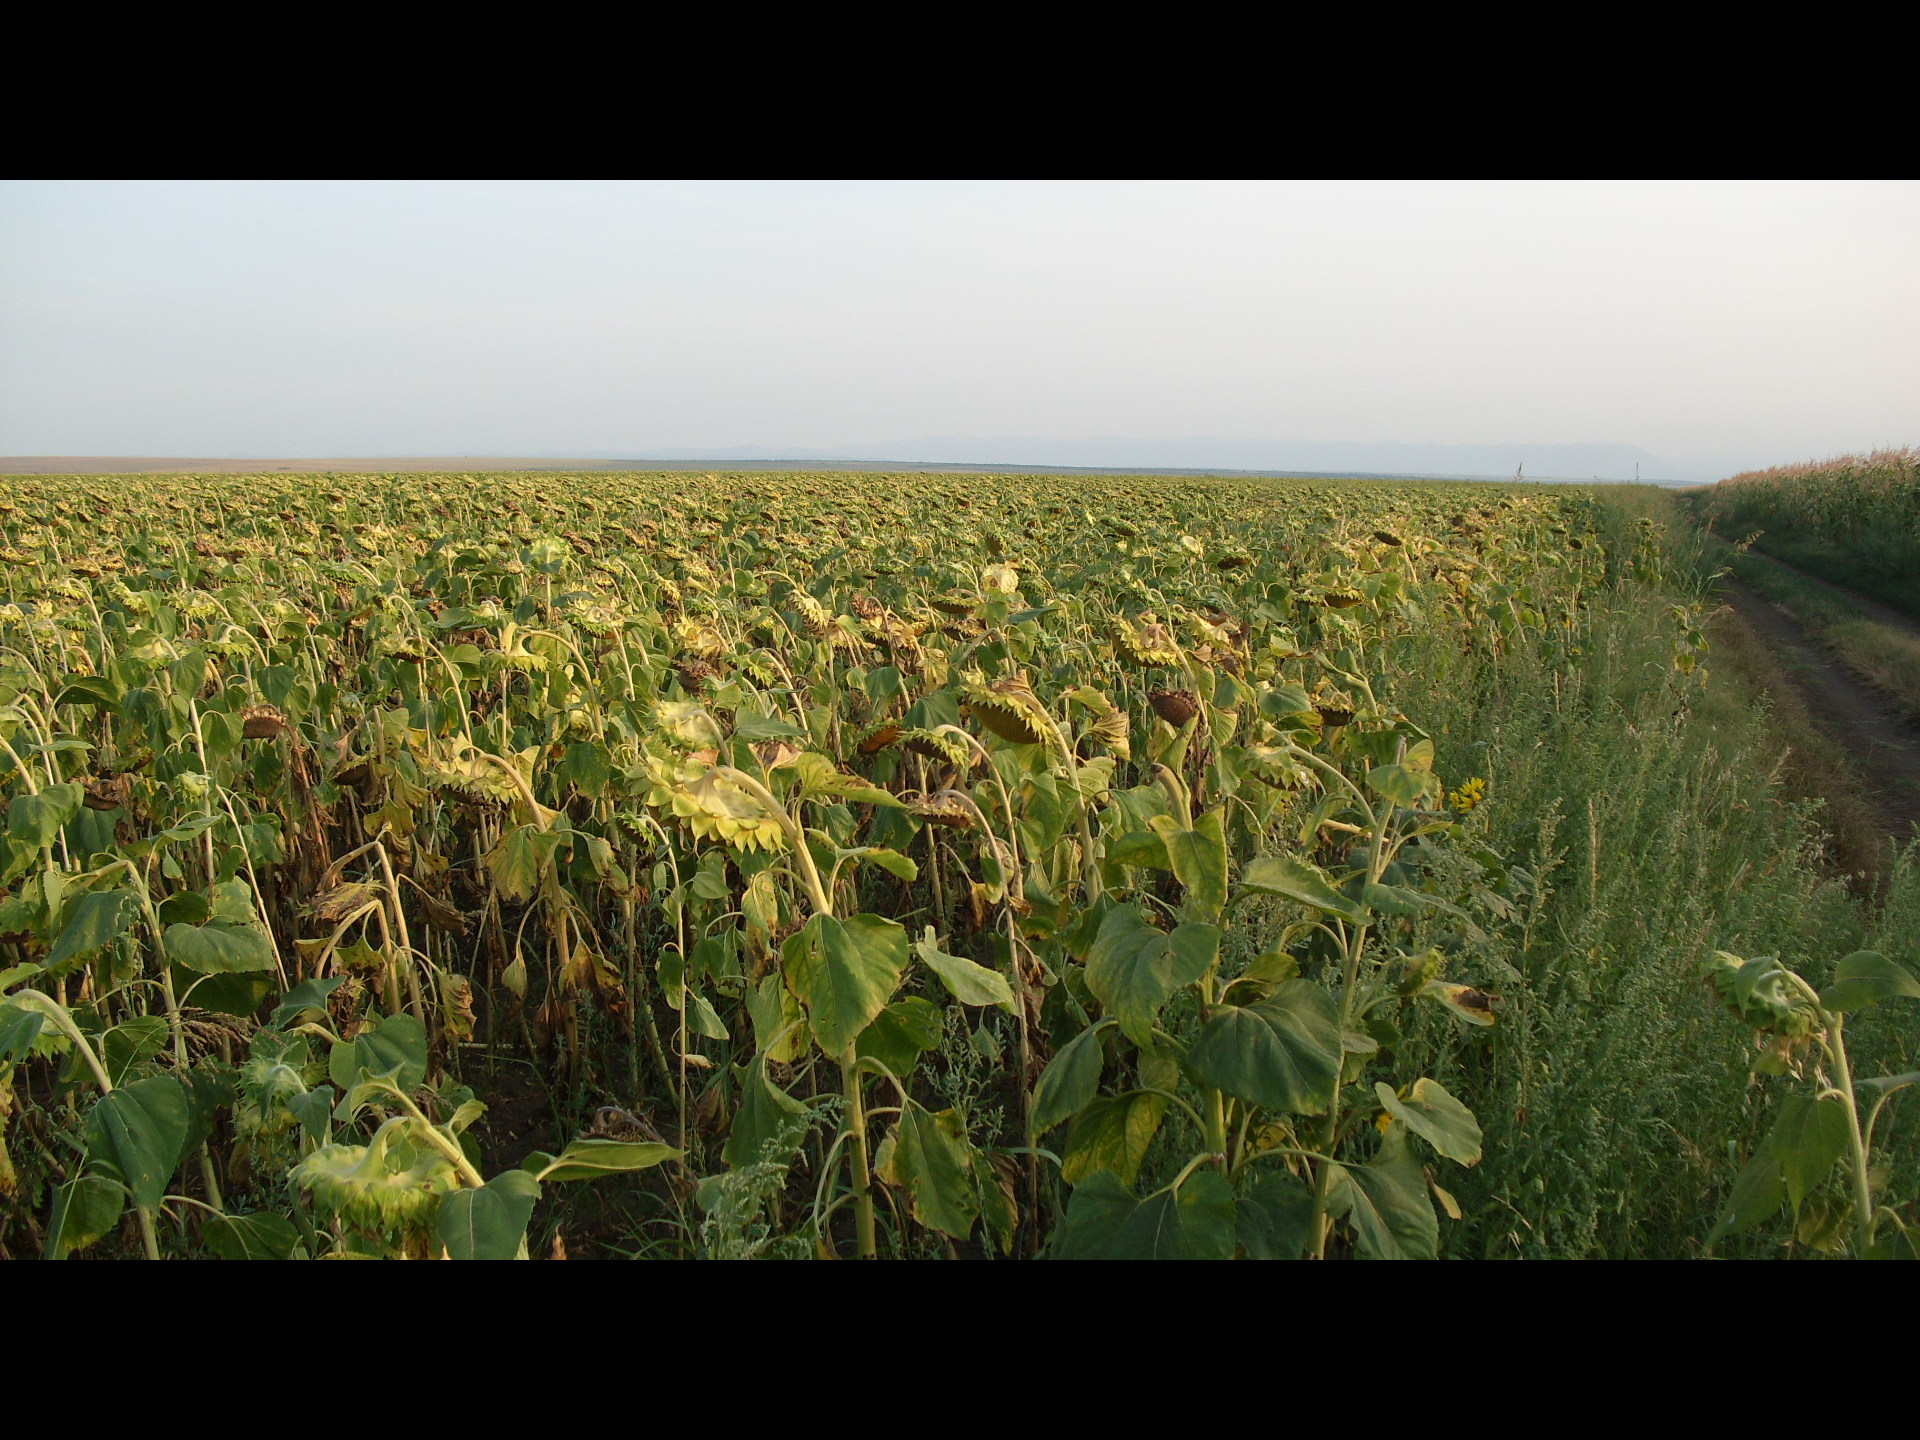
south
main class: Cropland
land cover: Sunflower
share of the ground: > 75 %
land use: Agriculture (excluding fallow land and kitchen gardens)
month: August
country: BG
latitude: 43.5951
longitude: 23.6109
